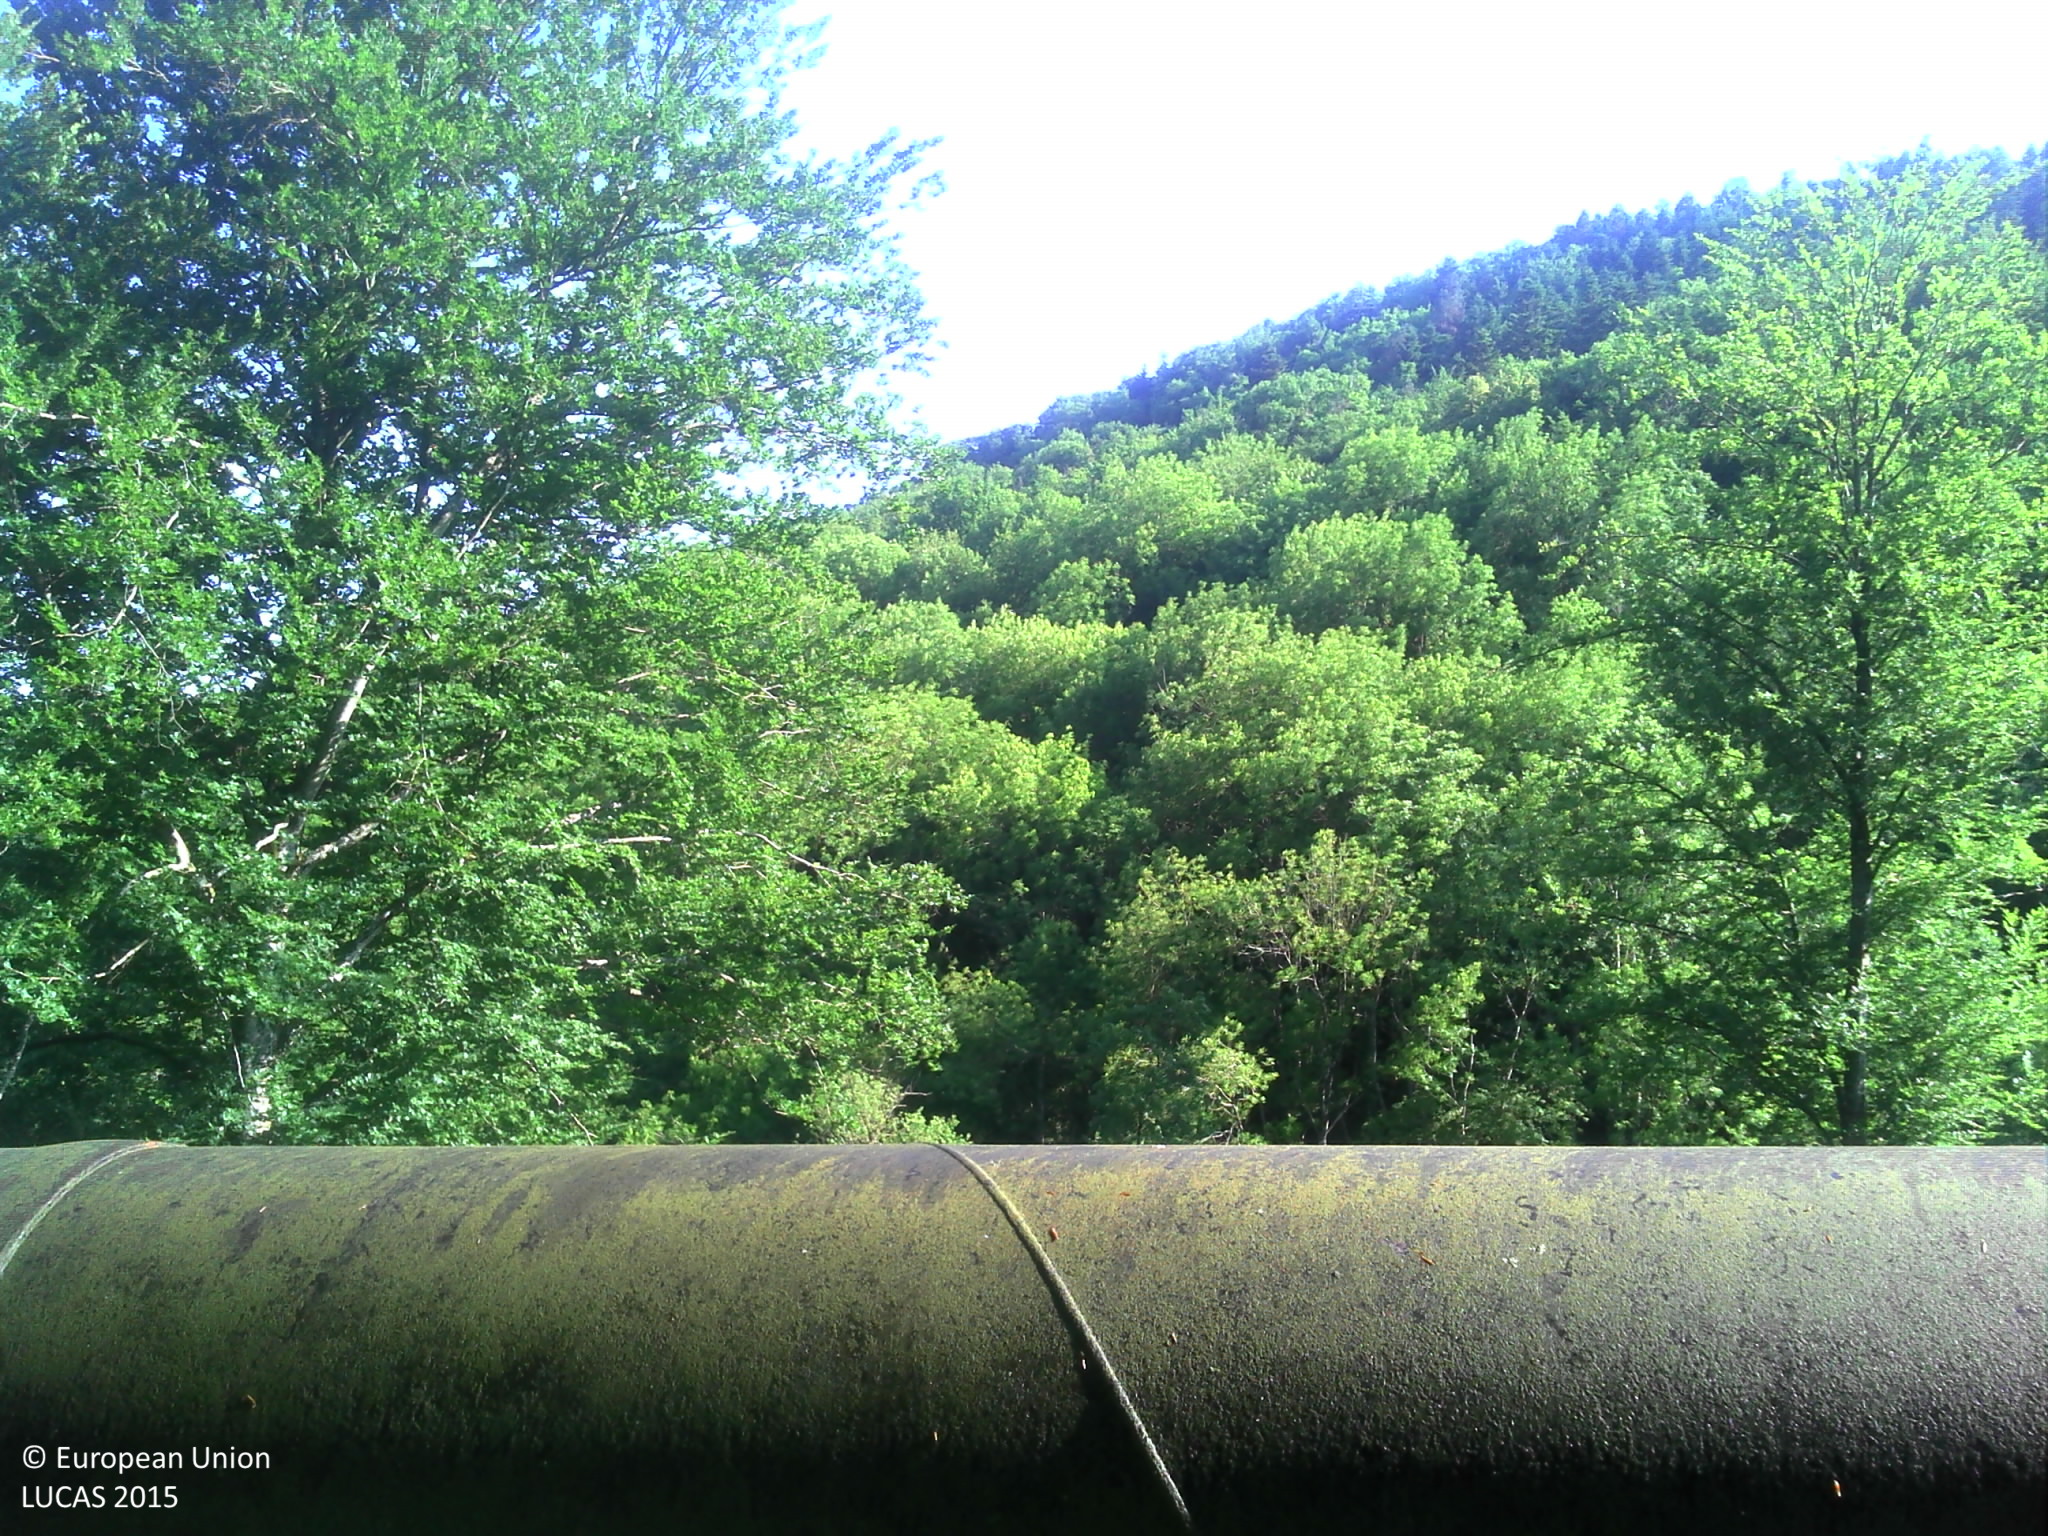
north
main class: Woodland
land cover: Broadleaved woodland
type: mesophytic deciduous forest
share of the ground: > 75 %
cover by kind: broadleaved forest trees 100 %
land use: Forestry
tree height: > 5 m
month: June
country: FR
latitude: 43.4141
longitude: 2.0899
